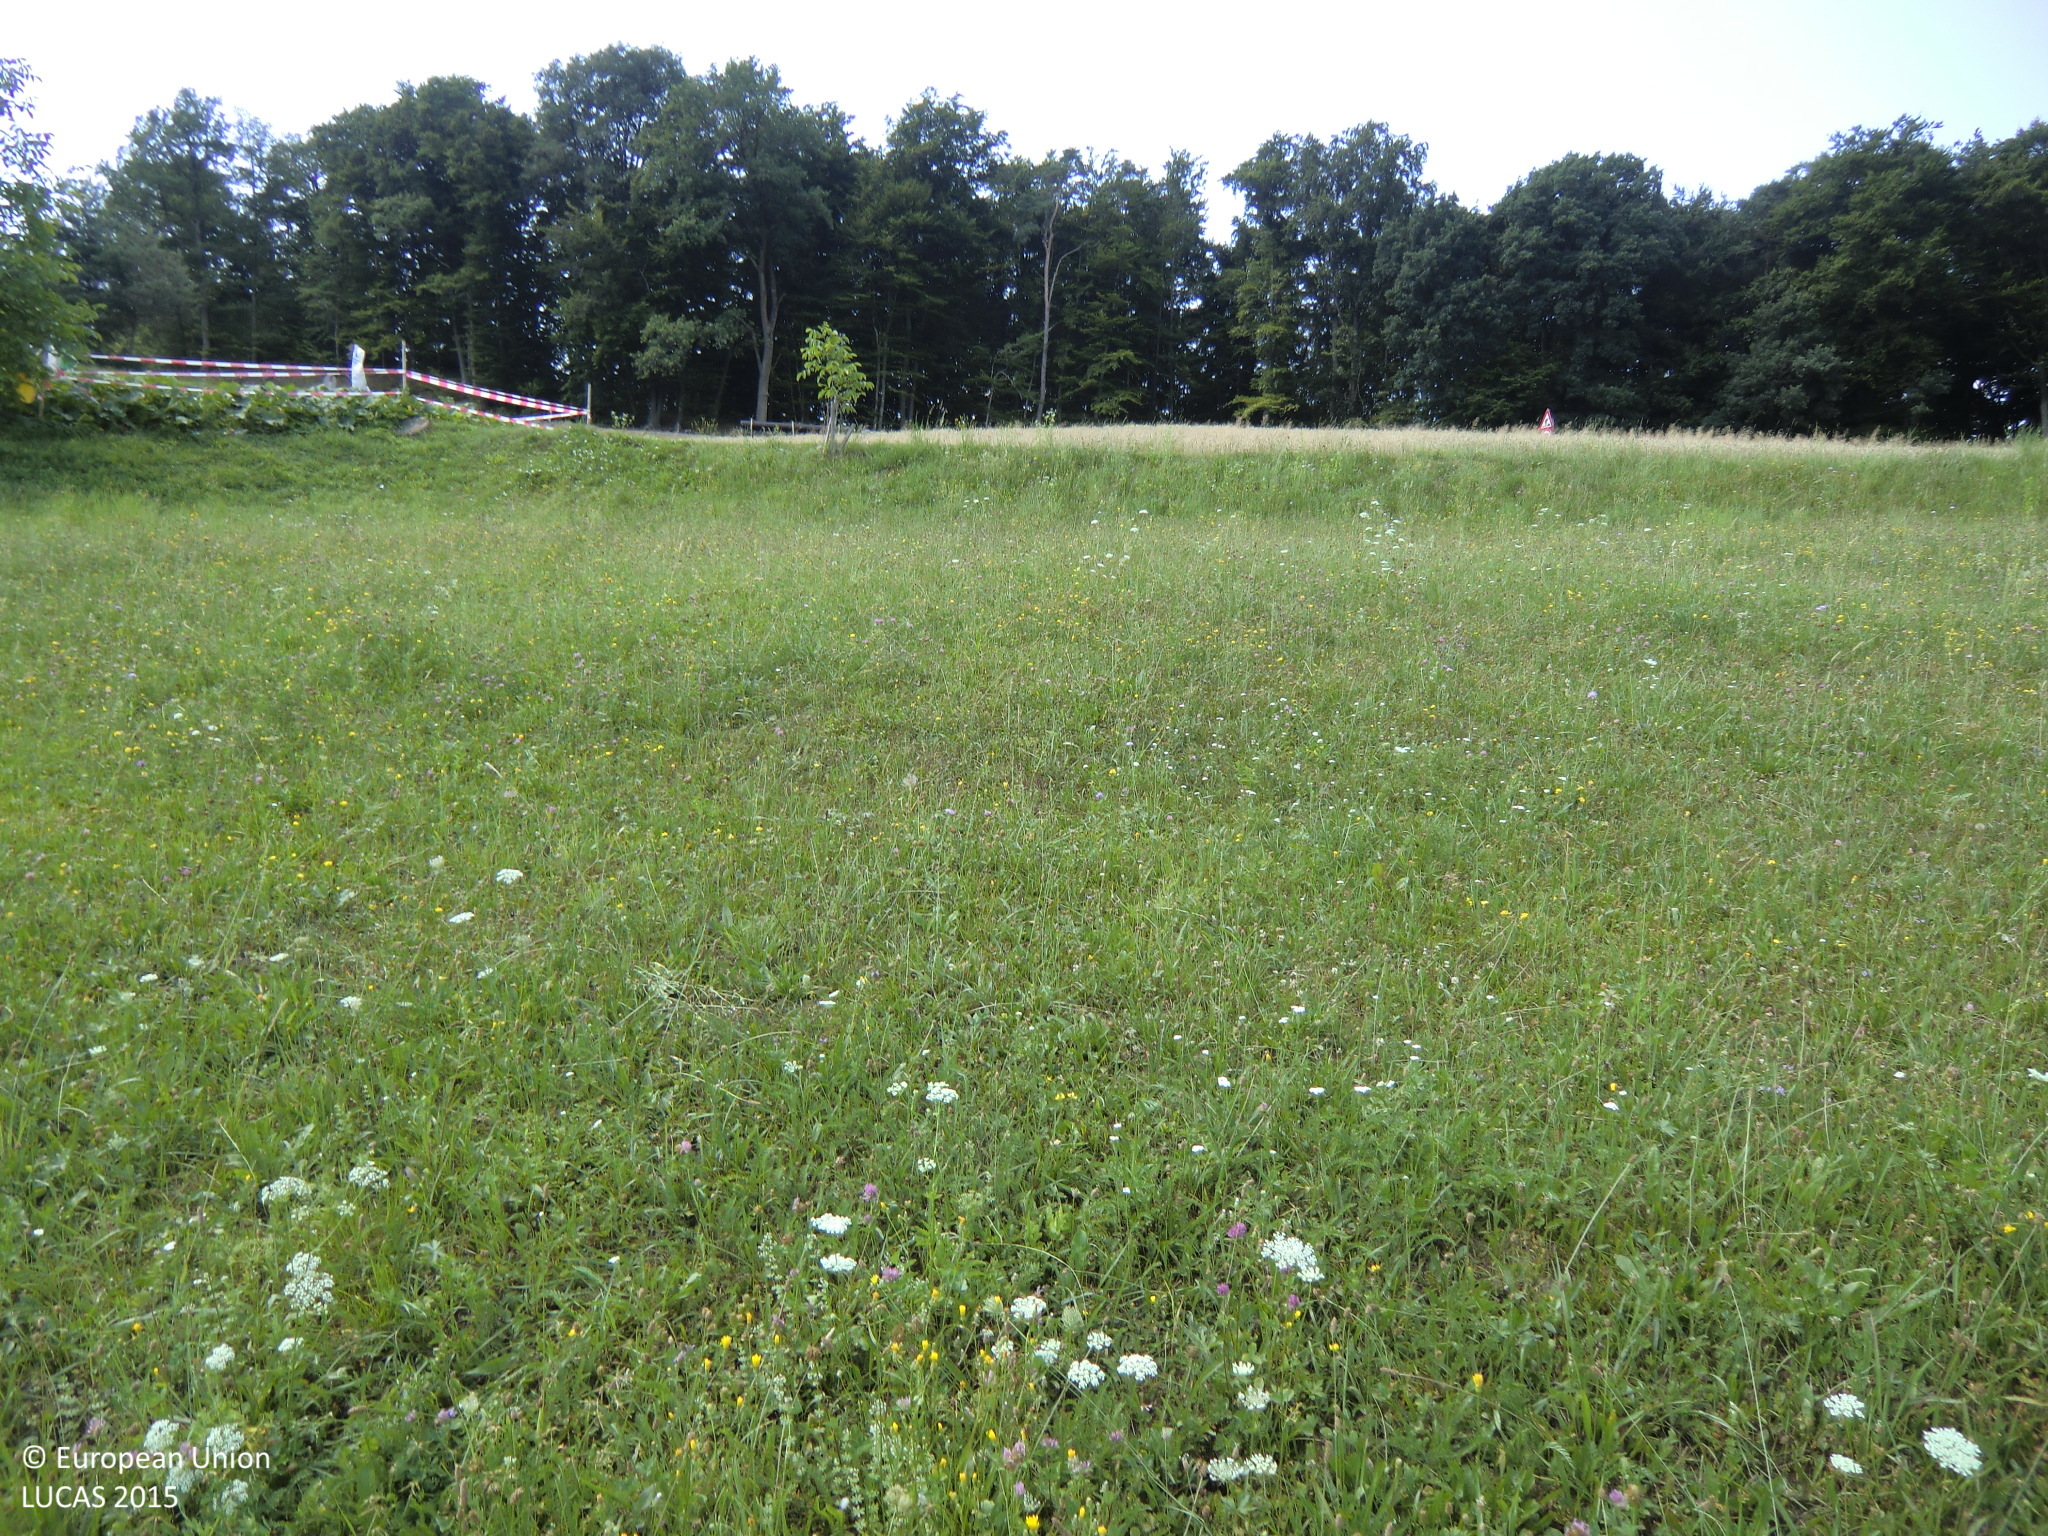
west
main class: Grassland
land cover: Grassland without tree/shrub cover
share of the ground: > 75 %
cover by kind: herbaceous plants 100 %
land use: Agriculture (excluding fallow land and kitchen gardens)
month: July
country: AT
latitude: 47.0112
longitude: 16.0388
